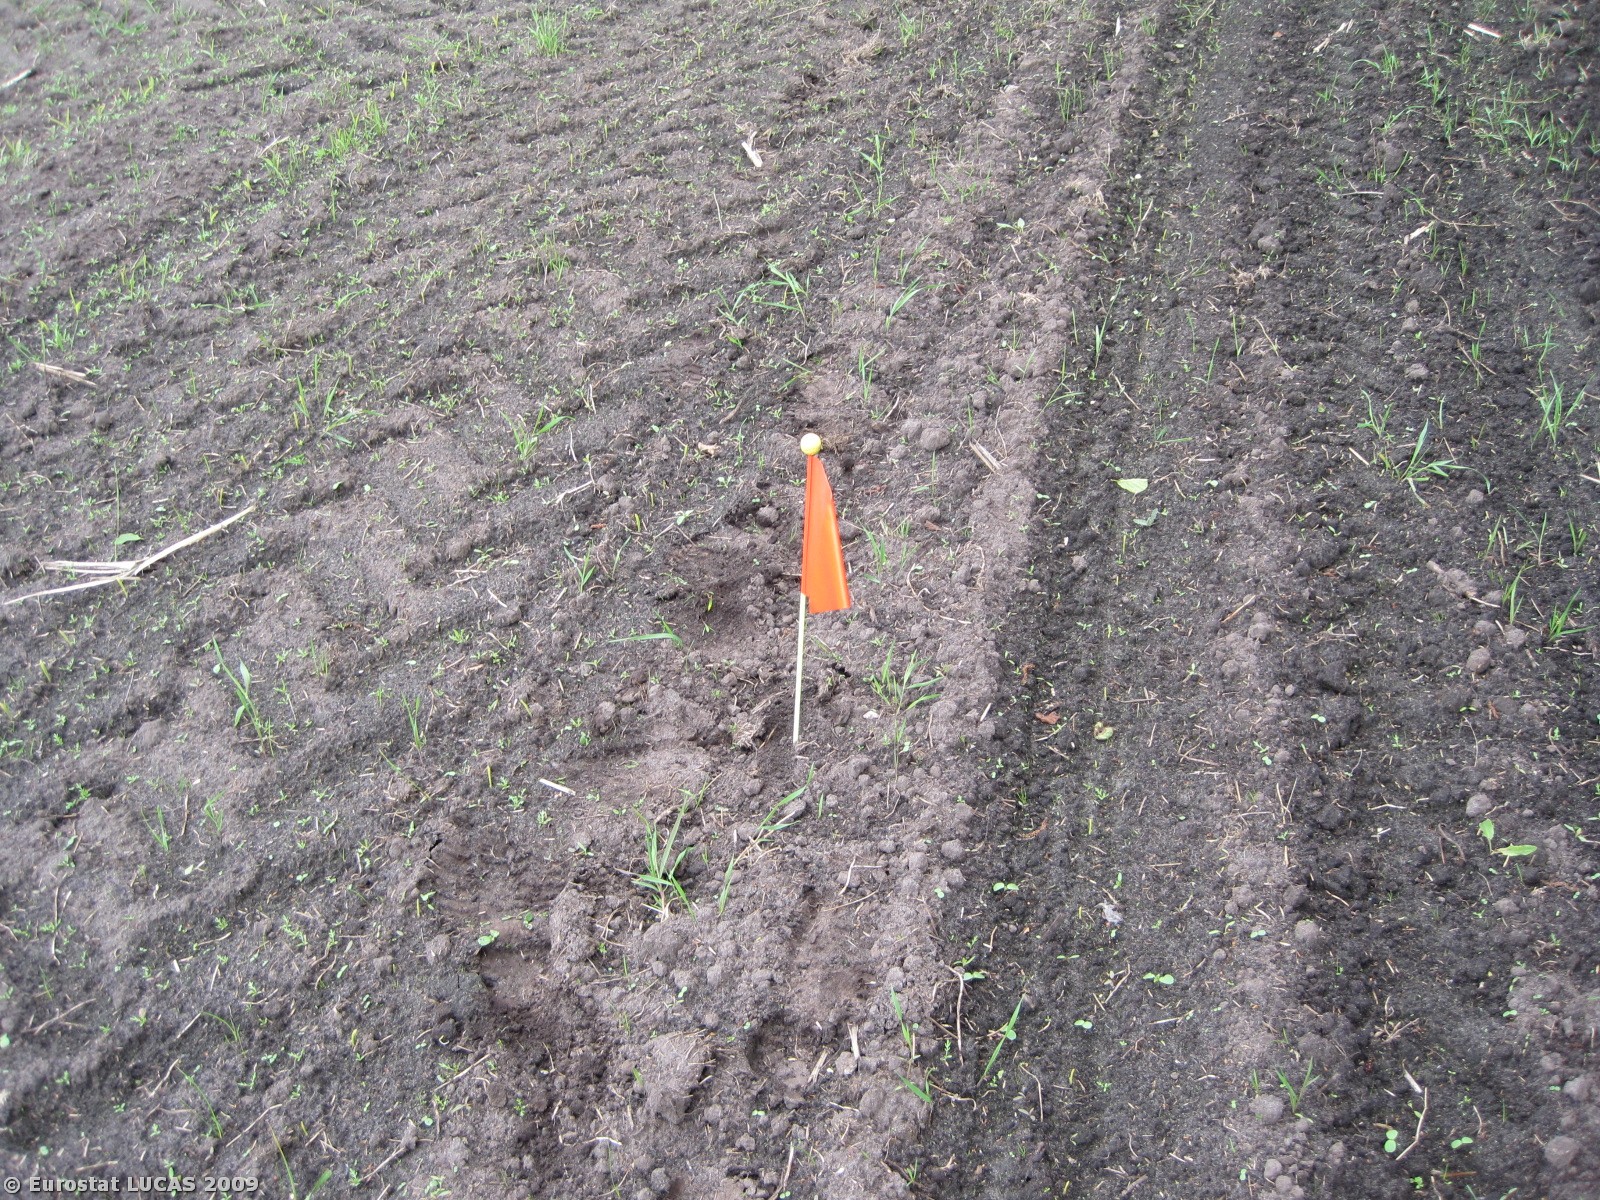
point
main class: Cropland
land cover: Maize
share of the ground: < 10 %
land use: Agriculture (excluding fallow land and kitchen gardens)
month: May
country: DK
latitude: 56.7270
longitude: 10.0490
